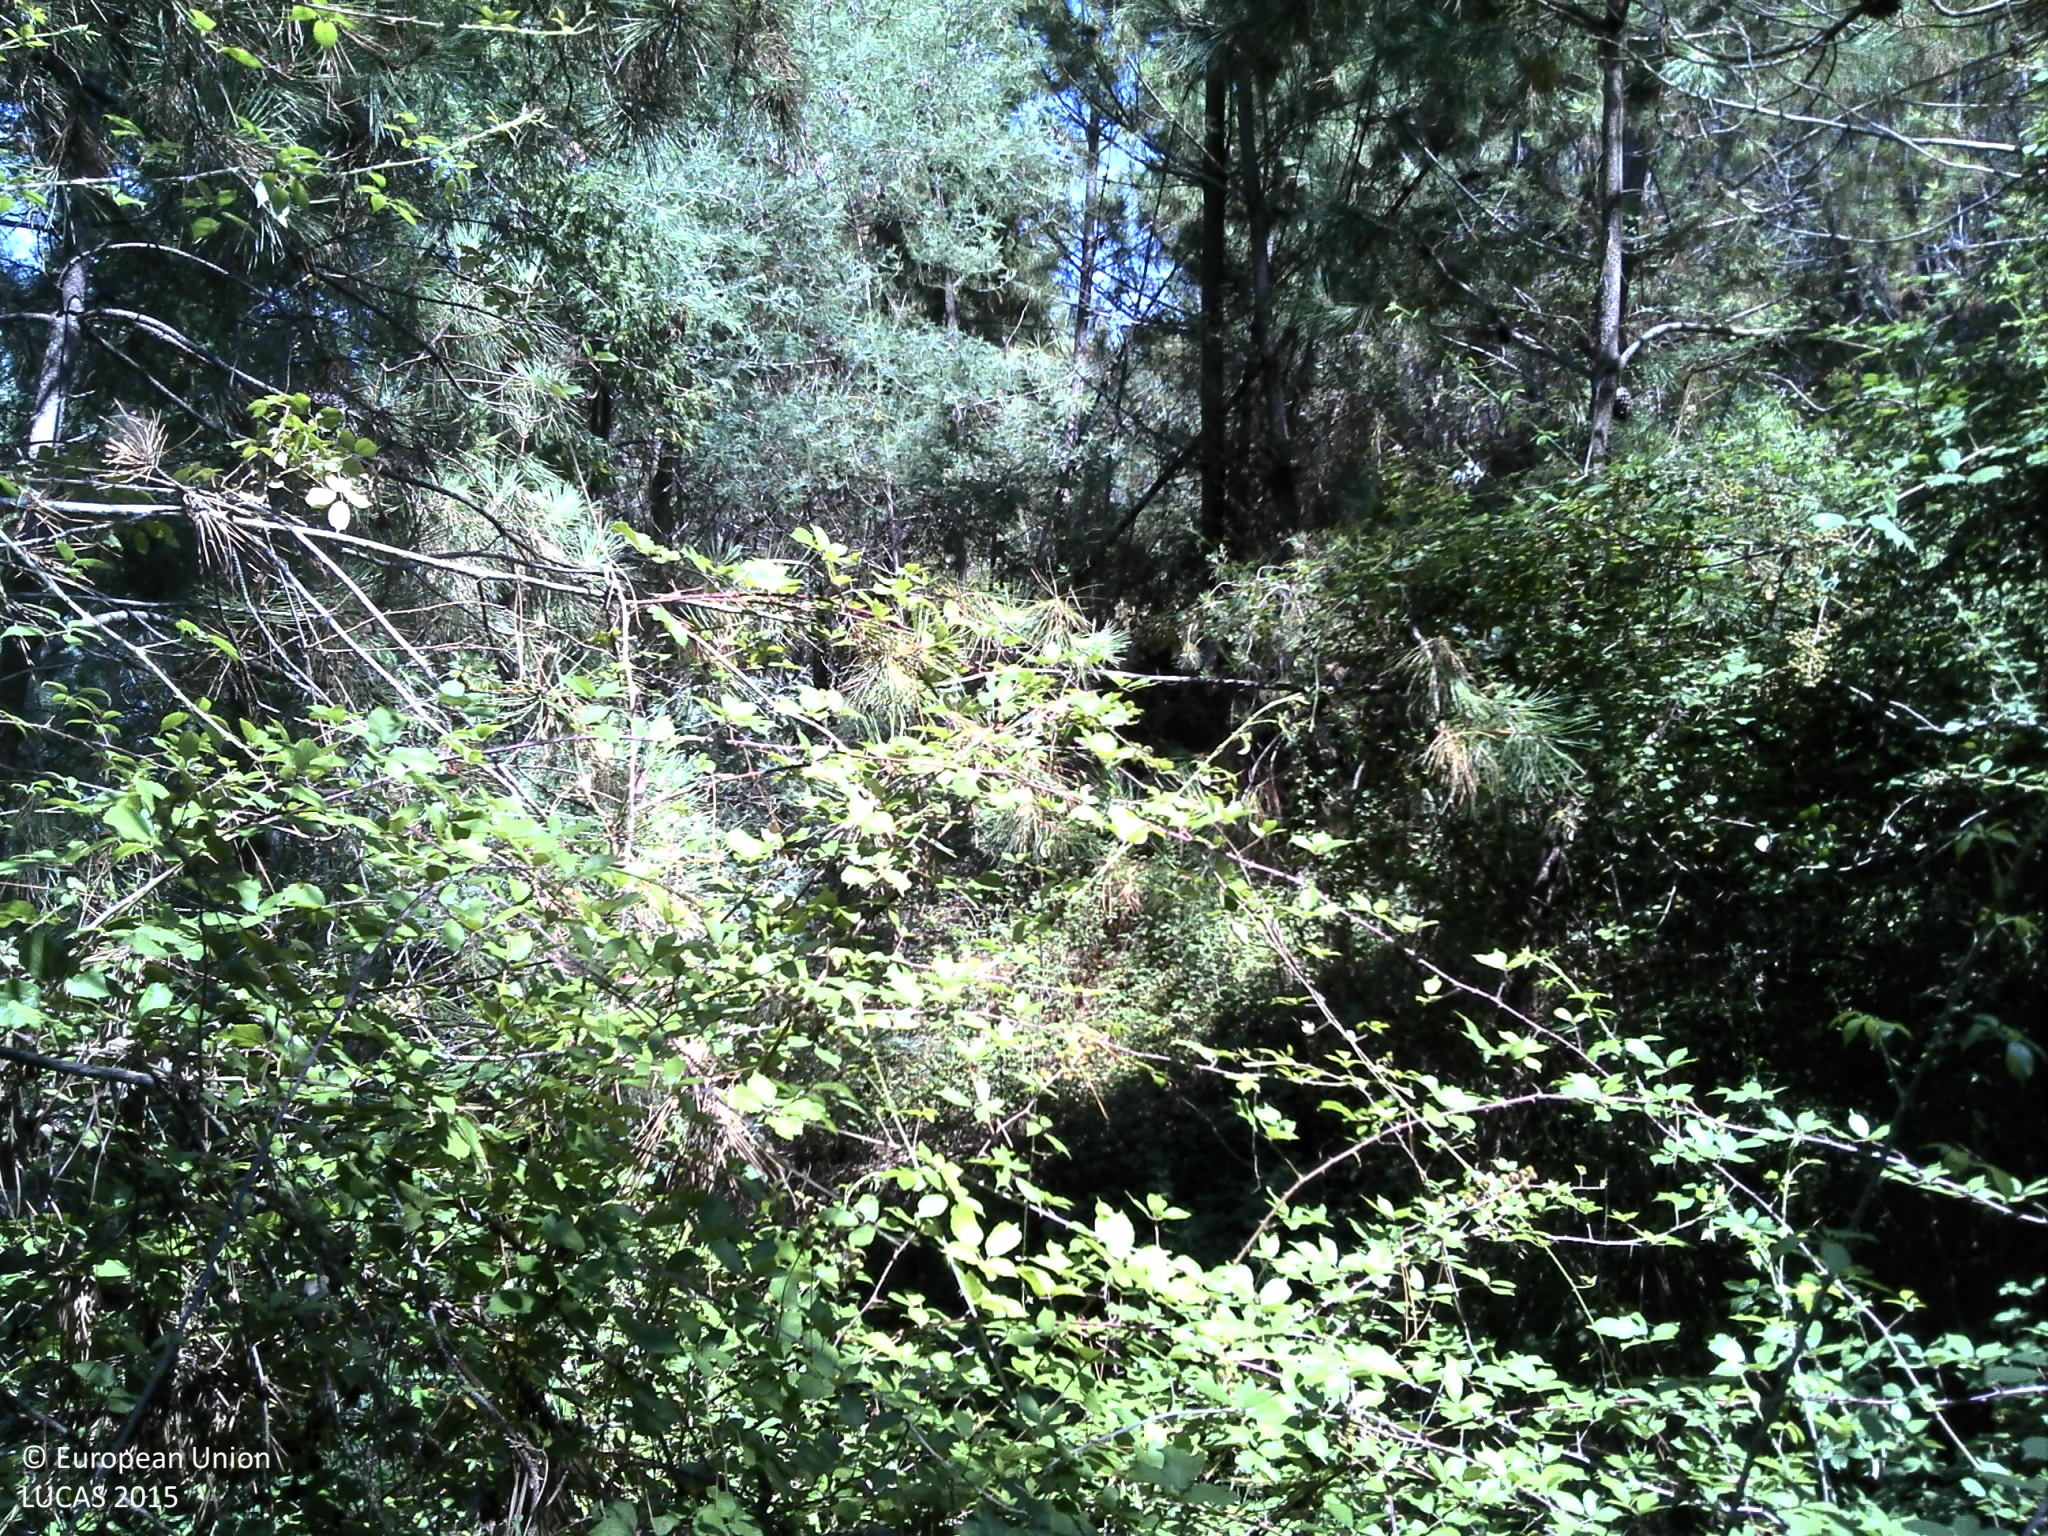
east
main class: Woodland
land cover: Pine dominated coniferous woodland
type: coniferous forest of the mediterranean region
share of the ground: 10 - 25 %
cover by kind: shrubs 80 %, coniferous forest trees 15 %, unconsolidated bare surface 5 %
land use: Forestry
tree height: > 5 m
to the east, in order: Pine dominated coniferous woodland; Tracks; Pine dominated coniferous woodland; Other bare soil; Tracks; Other bare soil
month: July
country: PT
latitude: 39.9309
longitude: -8.1257
